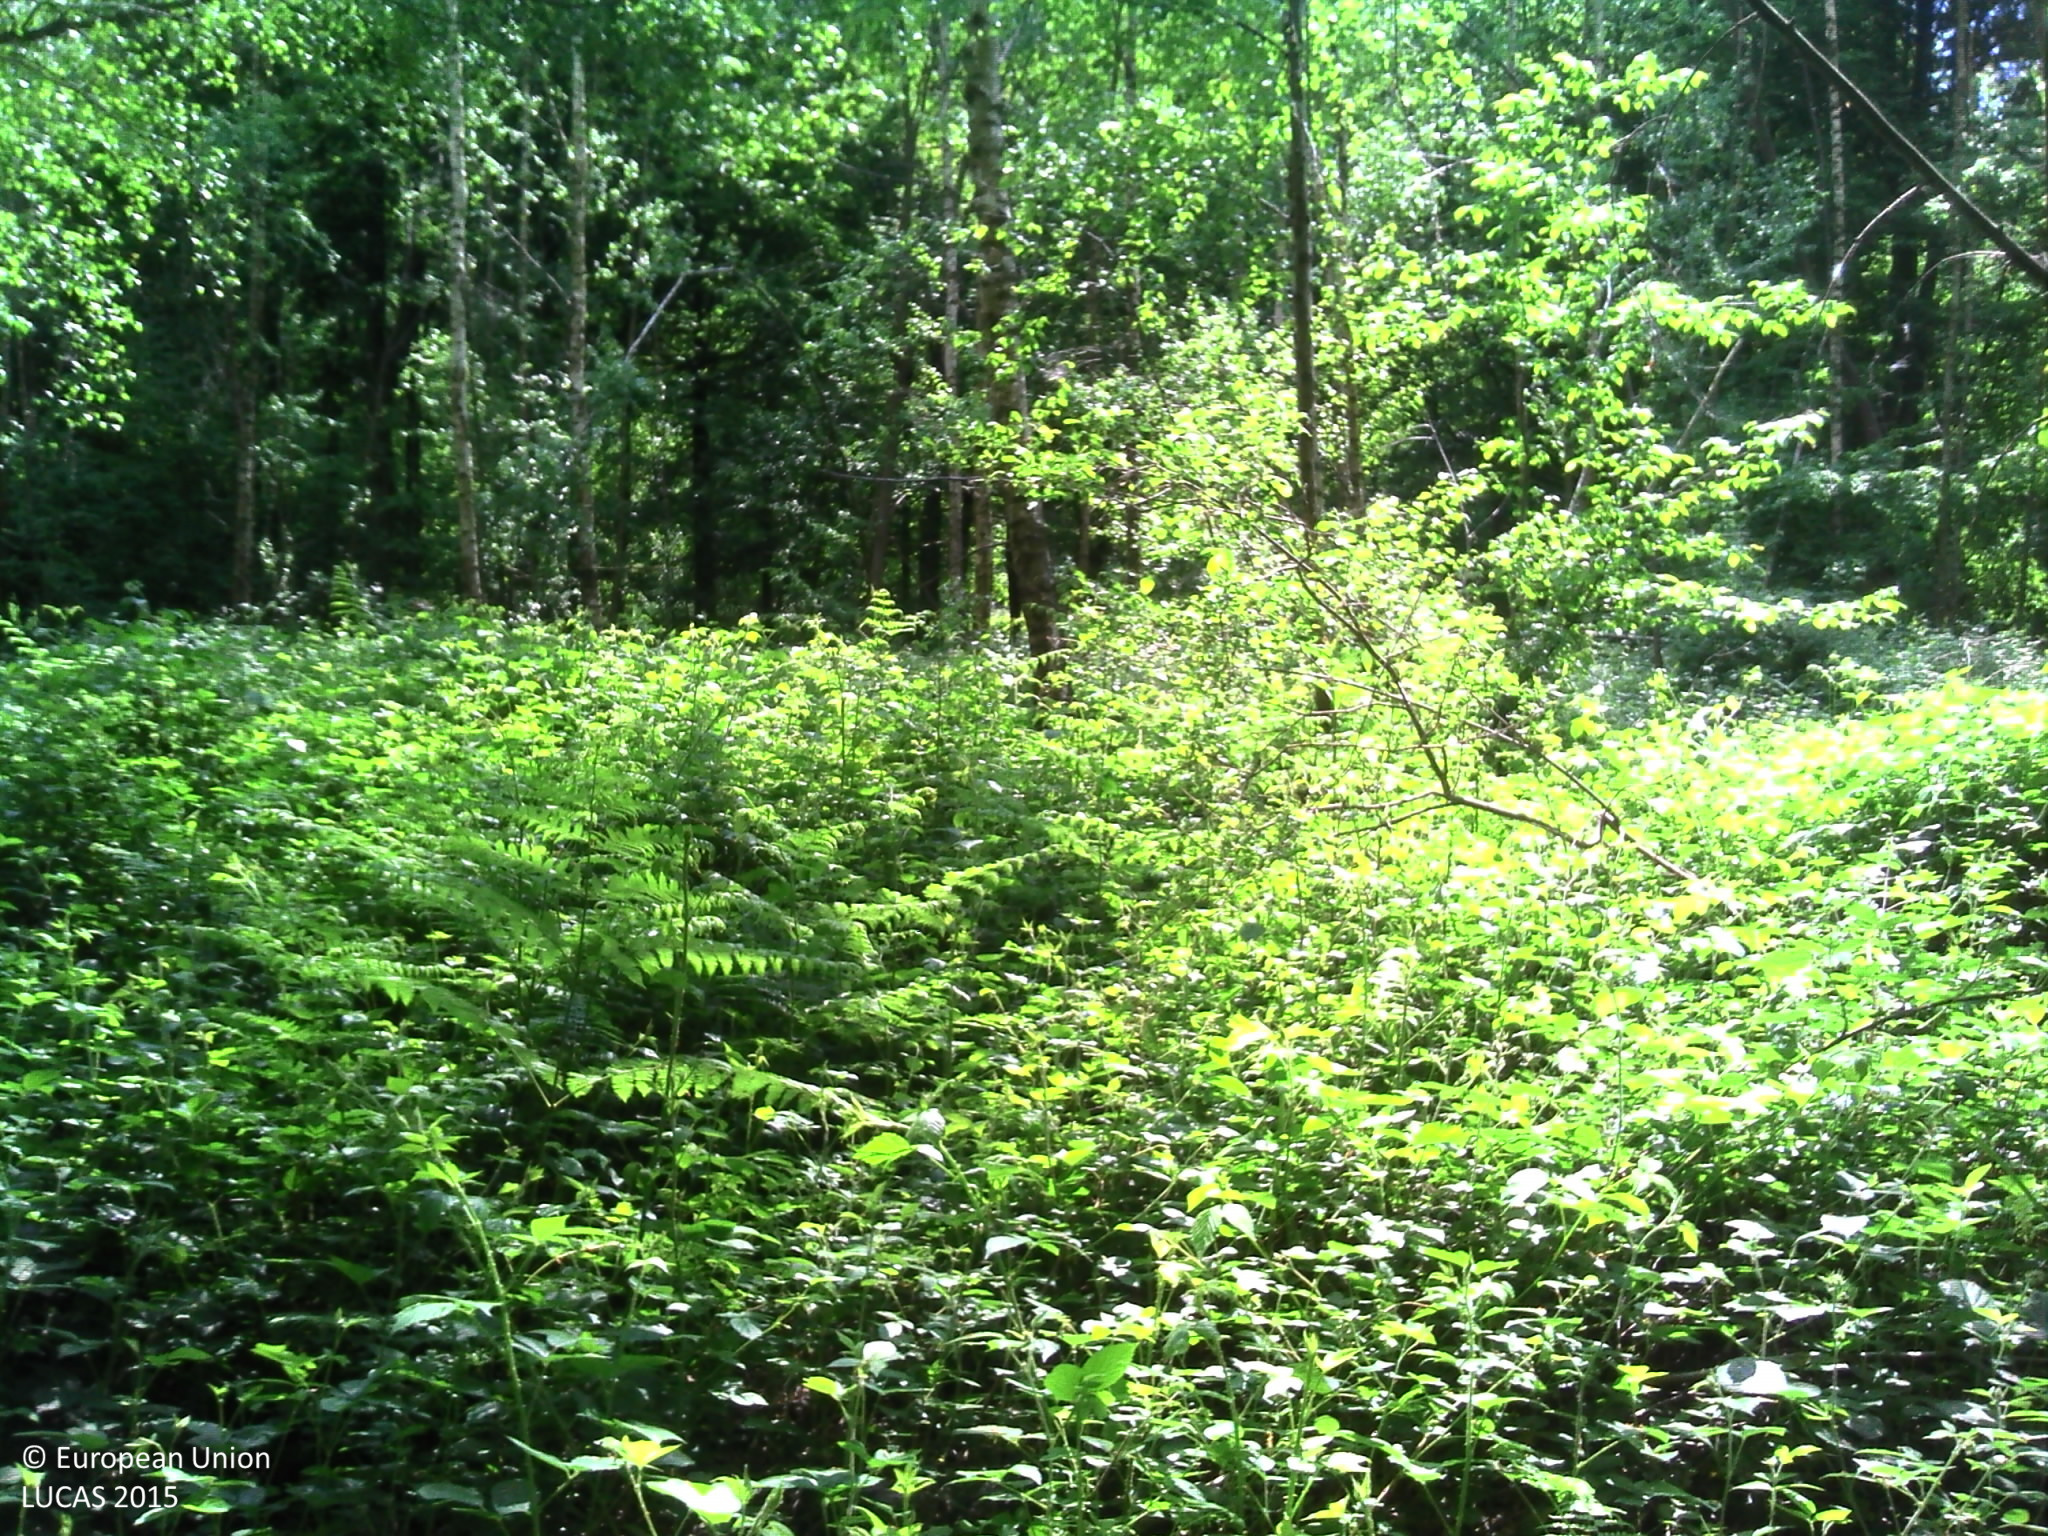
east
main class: Woodland
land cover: Broadleaved woodland
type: acidophilous oak and oak-birch forest
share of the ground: > 75 %
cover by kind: broadleaved forest trees 100 %
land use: Forestry
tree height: > 5 m
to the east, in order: Broadleaved woodland; Tracks; Broadleaved woodland; Grassland without tree/shrub cover; Tracks; Grassland without tree/shrub cover
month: May
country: BE
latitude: 50.6102
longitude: 4.4987
